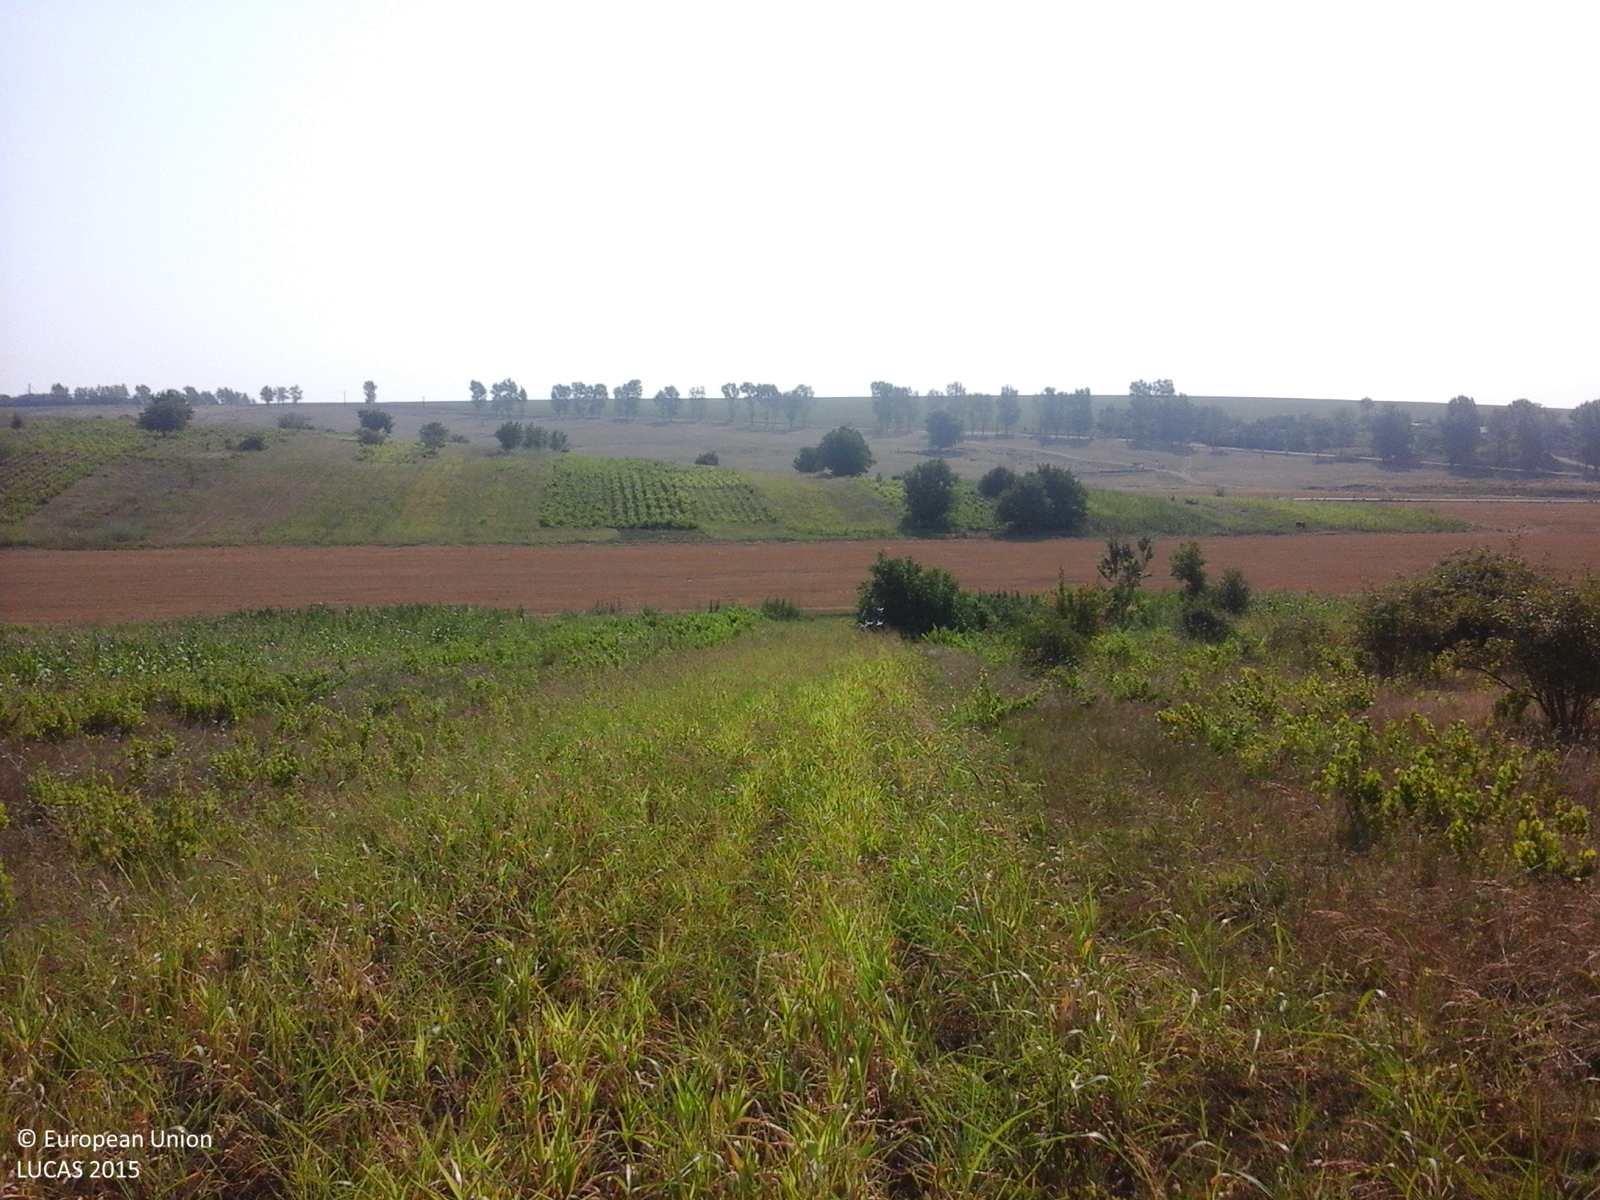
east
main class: Cropland
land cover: Maize
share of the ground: 50 - 75 %
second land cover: Spontaneously vegetated surfaces
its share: 25 - 50 %
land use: Agriculture (excluding fallow land and kitchen gardens)
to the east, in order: Maize; Spontaneously vegetated surfaces; Grass margins; Tracks; Common wheat; Spontaneously vegetated surfaces
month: July
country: RO
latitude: 45.7479
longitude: 27.8939
